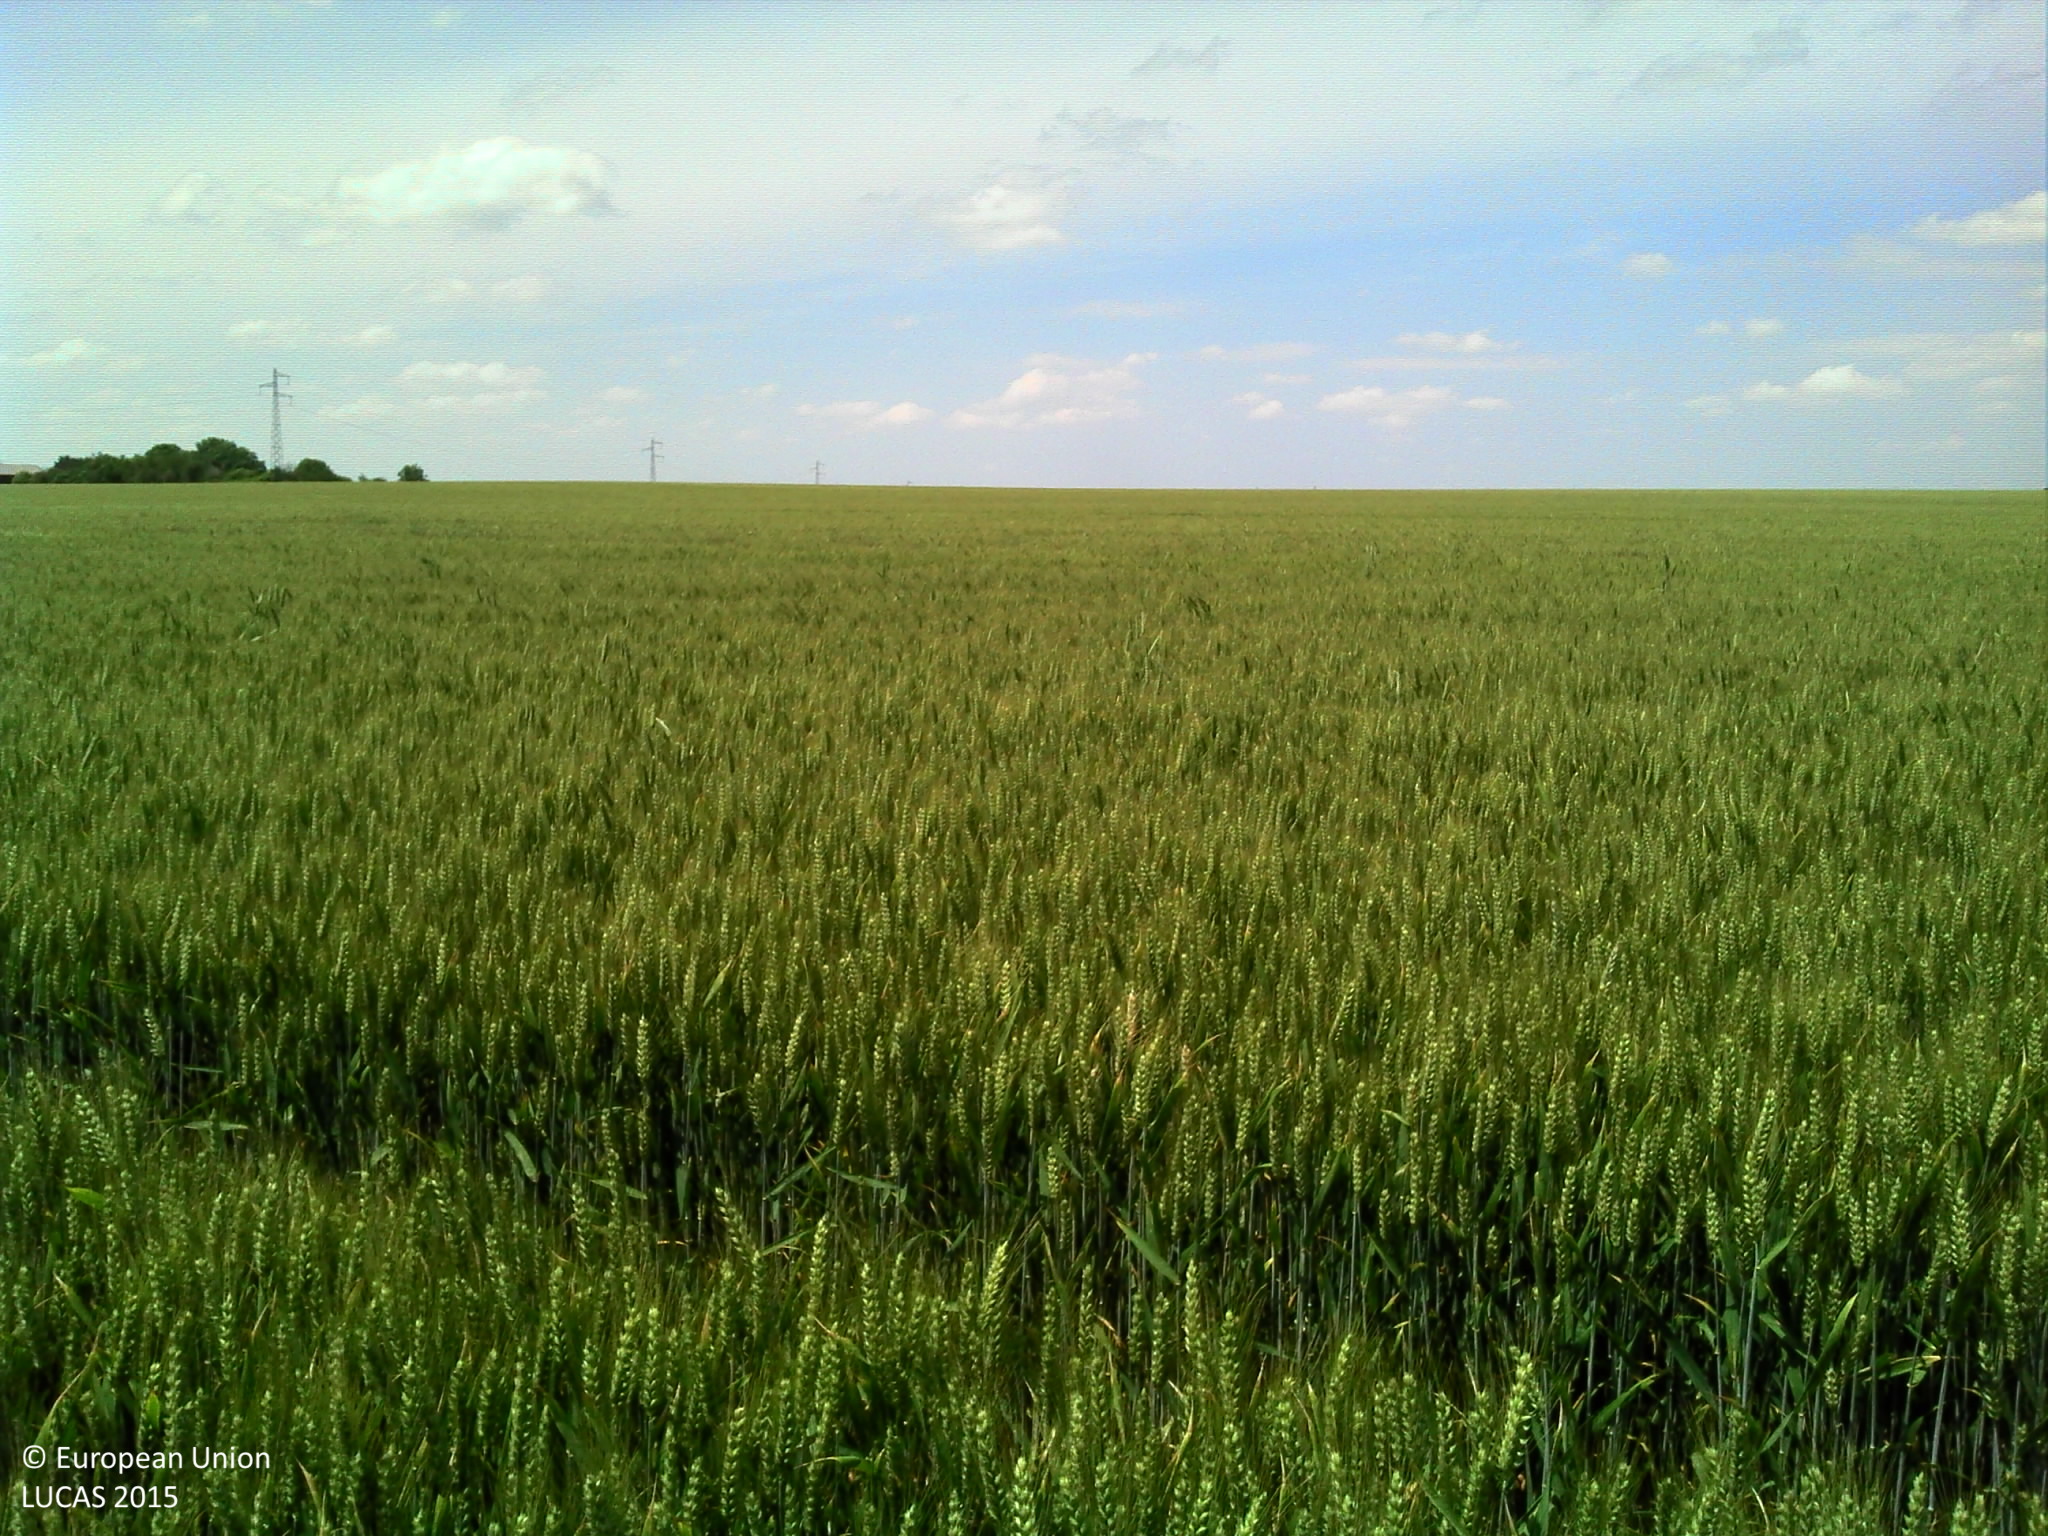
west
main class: Cropland
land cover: Common wheat
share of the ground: > 75 %
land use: Agriculture (excluding fallow land and kitchen gardens)
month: June
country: FR
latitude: 46.9497
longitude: 2.6761
